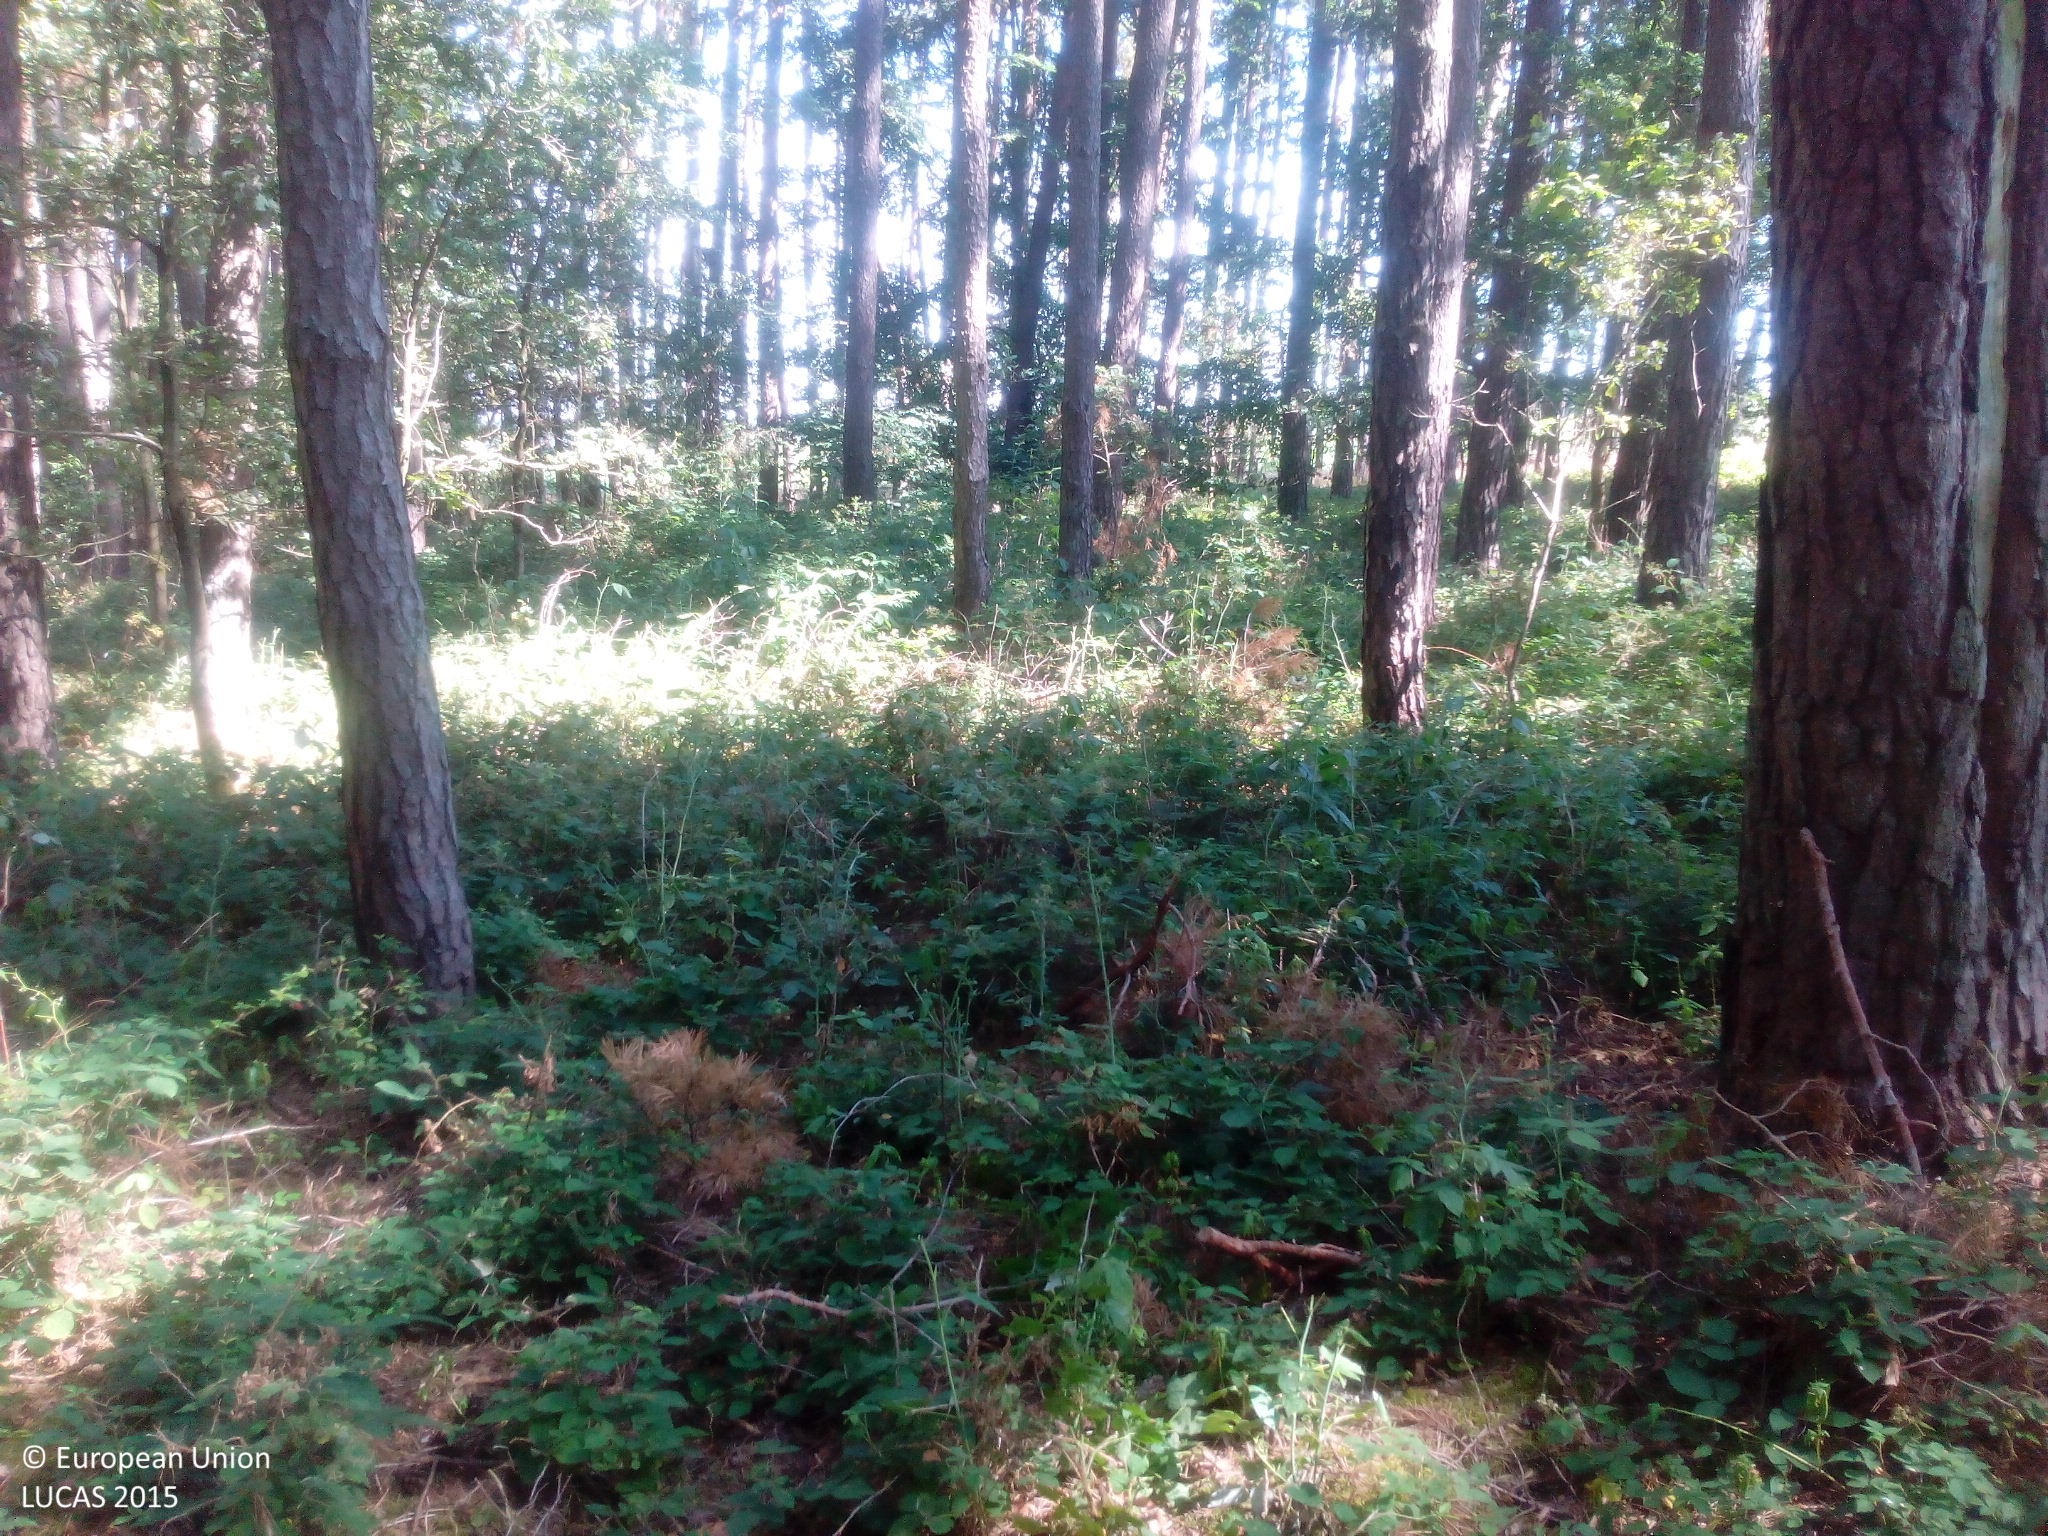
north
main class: Woodland
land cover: Other mixed woodland
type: hemiboreal forest and nemoral coniferous forest and mixed broadleaved-coniferous forest
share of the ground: > 75 %
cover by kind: coniferous forest trees 60 %, broadleaved forest trees 25 %, herbaceous plants 15 %
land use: Forestry
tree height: > 5 m
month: July
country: DE
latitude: 49.3352
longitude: 10.9217
